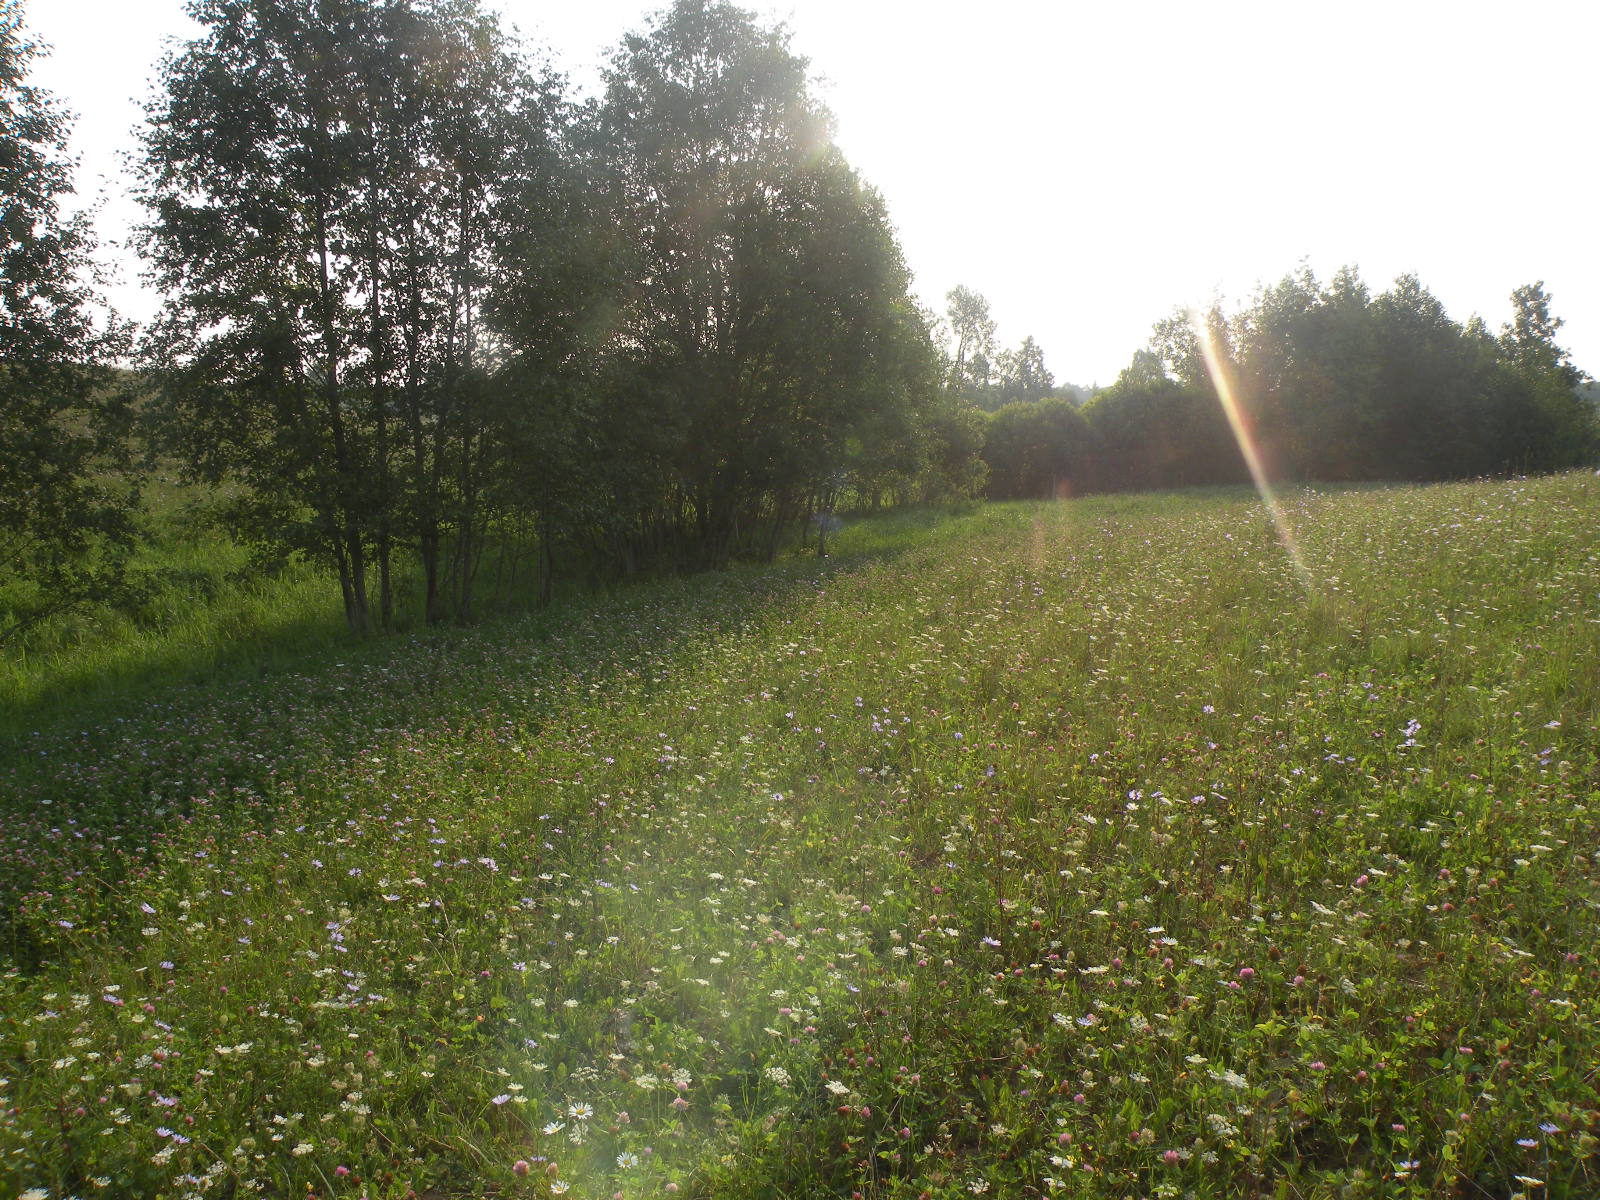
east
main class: Grassland
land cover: Grassland without tree/shrub cover
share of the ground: > 75 %
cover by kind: herbaceous plants 85 %, unconsolidated bare surface 15 %
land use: Agriculture (excluding fallow land and kitchen gardens)
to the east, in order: Grassland without tree/shrub cover; Broadleaved woodland; Grassland without tree/shrub cover; Broadleaved woodland; Grassland without tree/shrub cover; Spontaneously vegetated surfaces; Broadleaved woodland
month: August
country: LV
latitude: 55.7299
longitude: 26.6692
